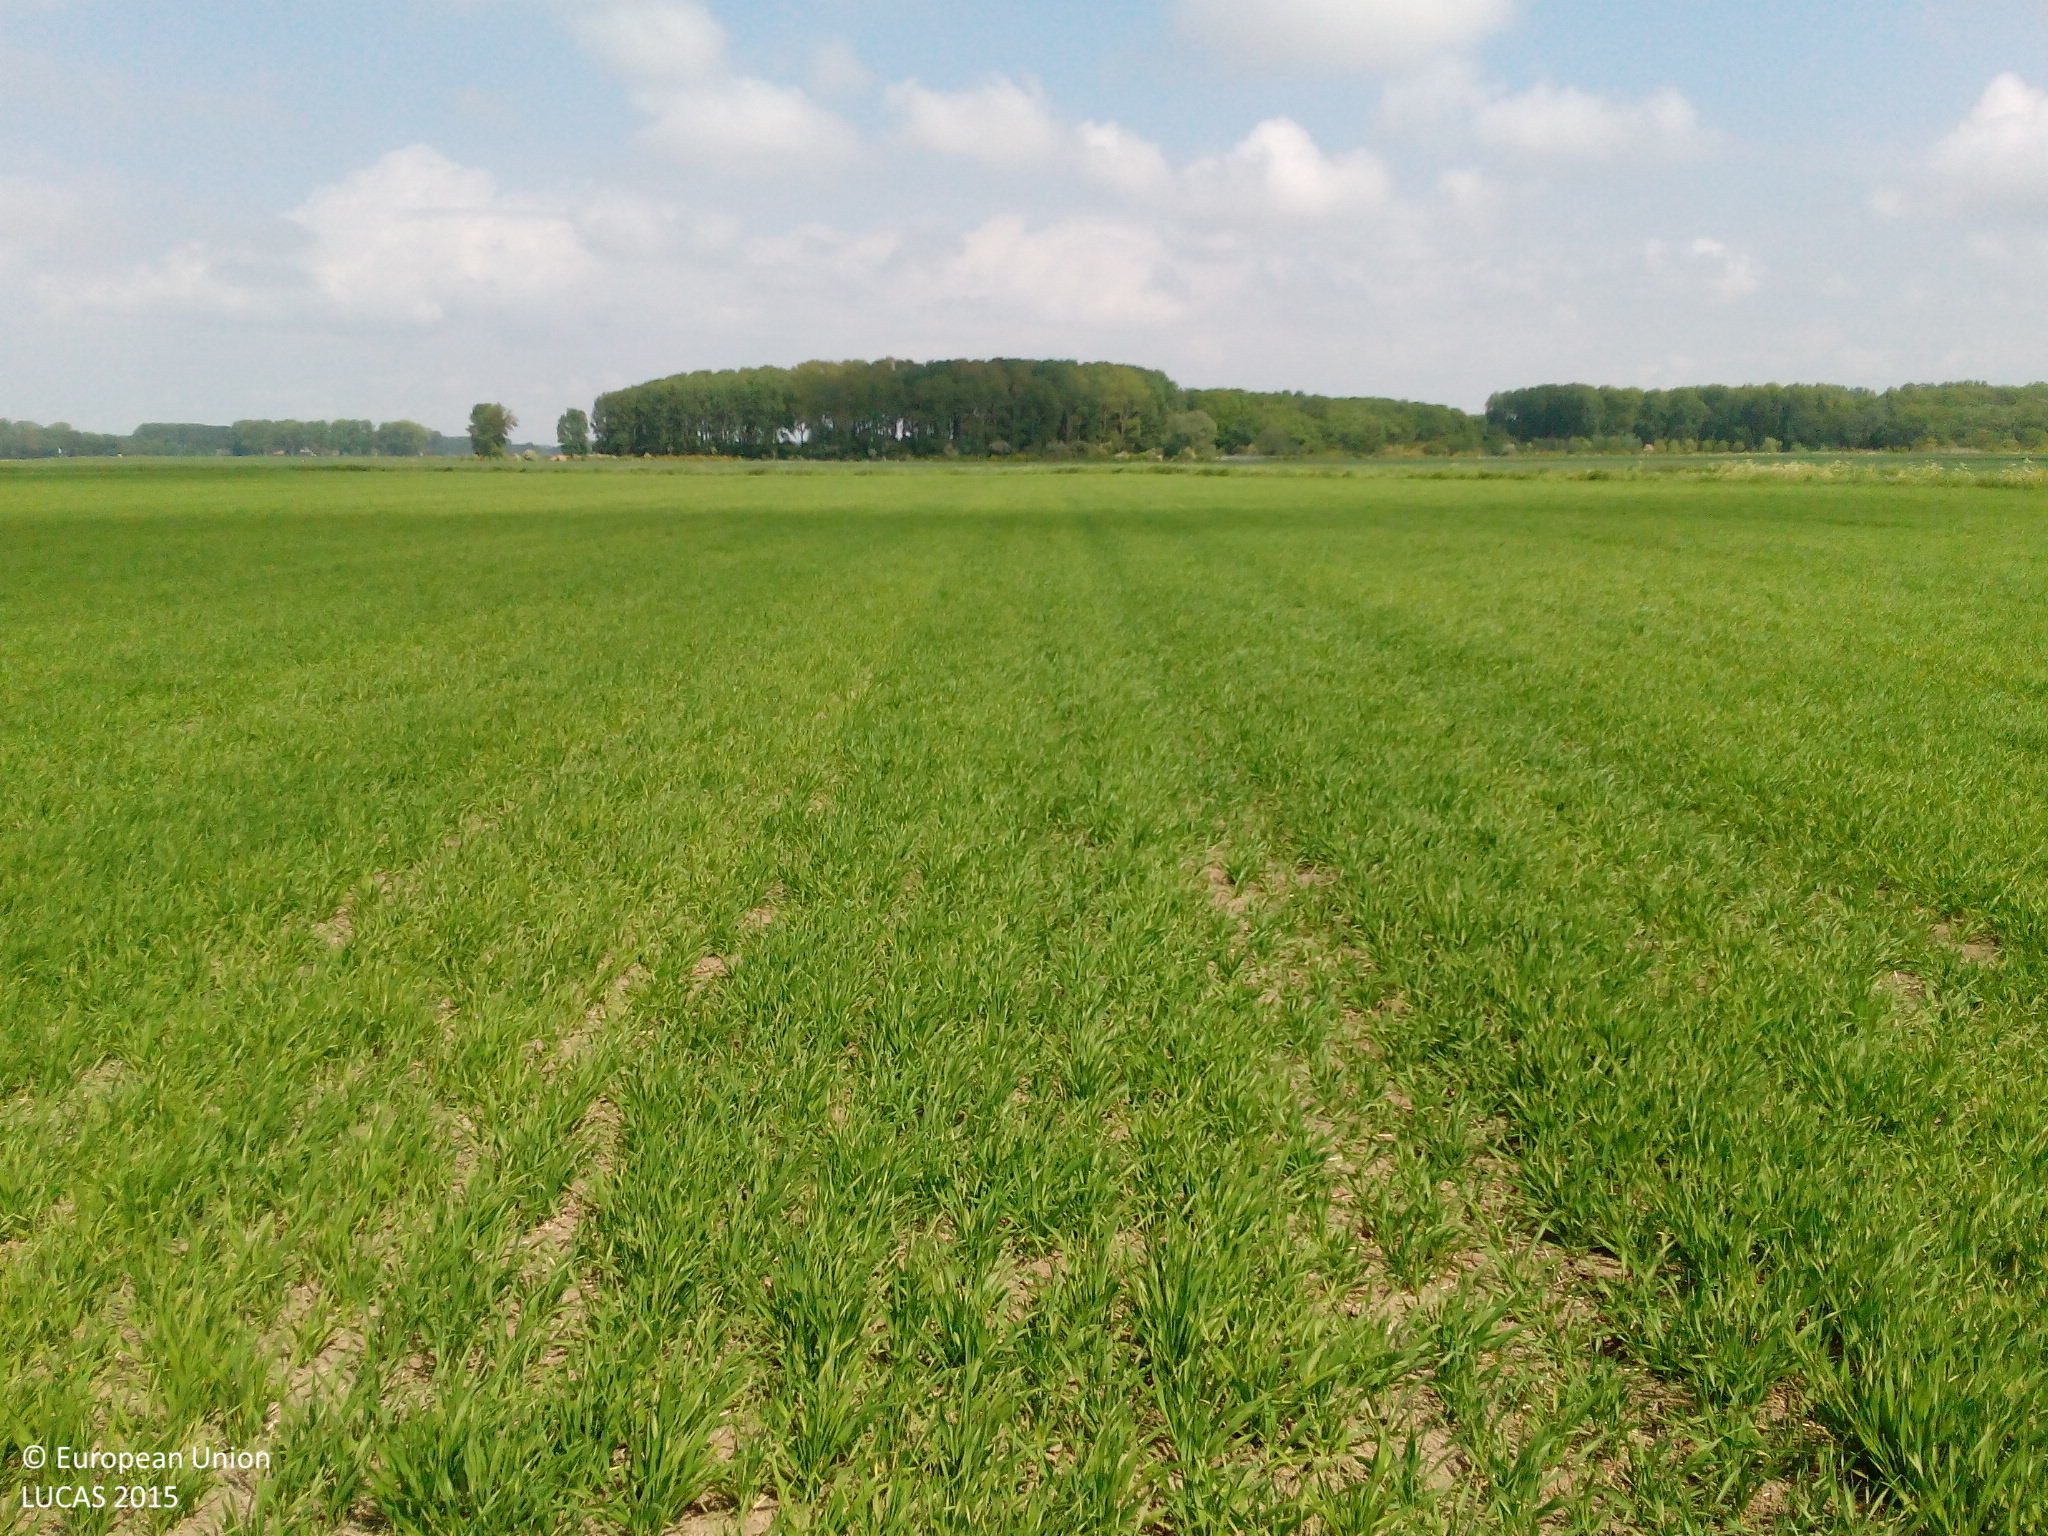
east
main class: Cropland
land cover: Barley
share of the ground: > 75 %
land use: Agriculture (excluding fallow land and kitchen gardens)
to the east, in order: Barley; Ditches and canals; Grass margins; Common wheat
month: May
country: NL
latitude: 51.3657
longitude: 3.4279
